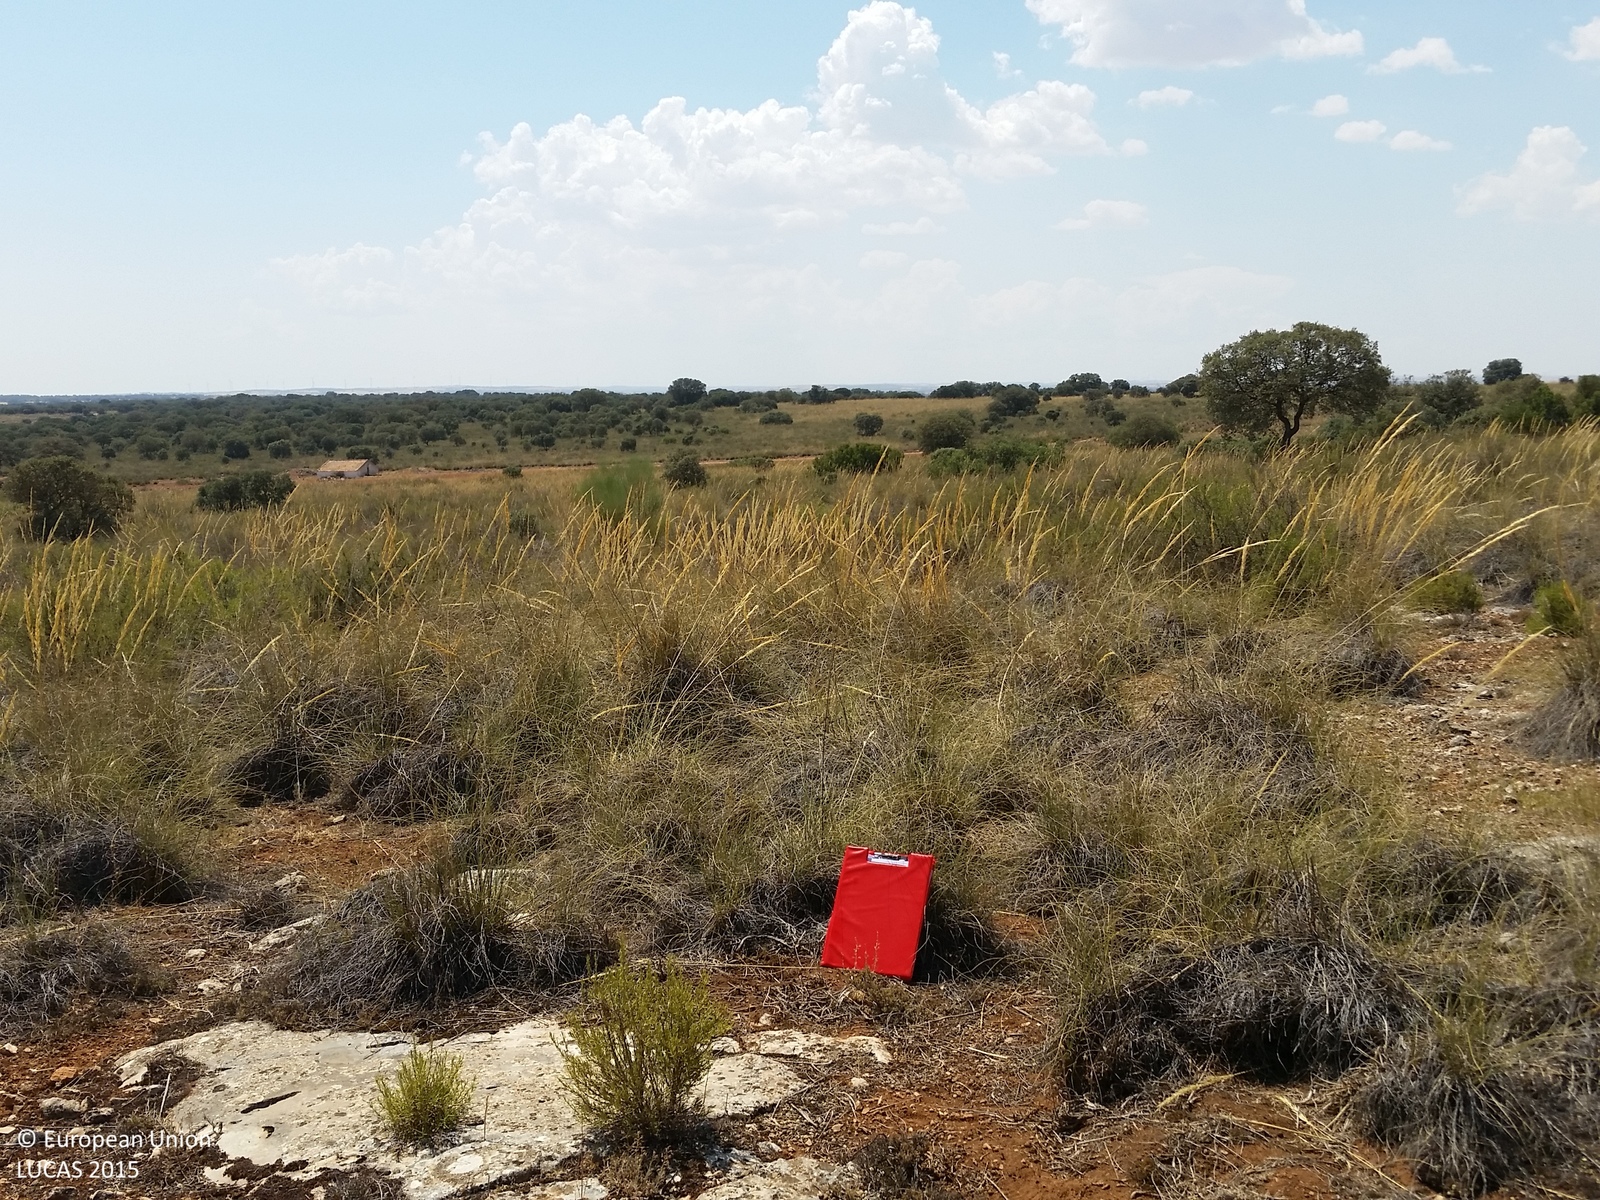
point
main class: Shrubland
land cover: Shrubland without tree cover
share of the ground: > 75 %
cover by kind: shrubs 75 %, herbaceous plants 15 %, consolidated bare surface 10 %
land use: Semi-natural and natural areas not in use
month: July
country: ES
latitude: 39.2049
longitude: -2.5267
